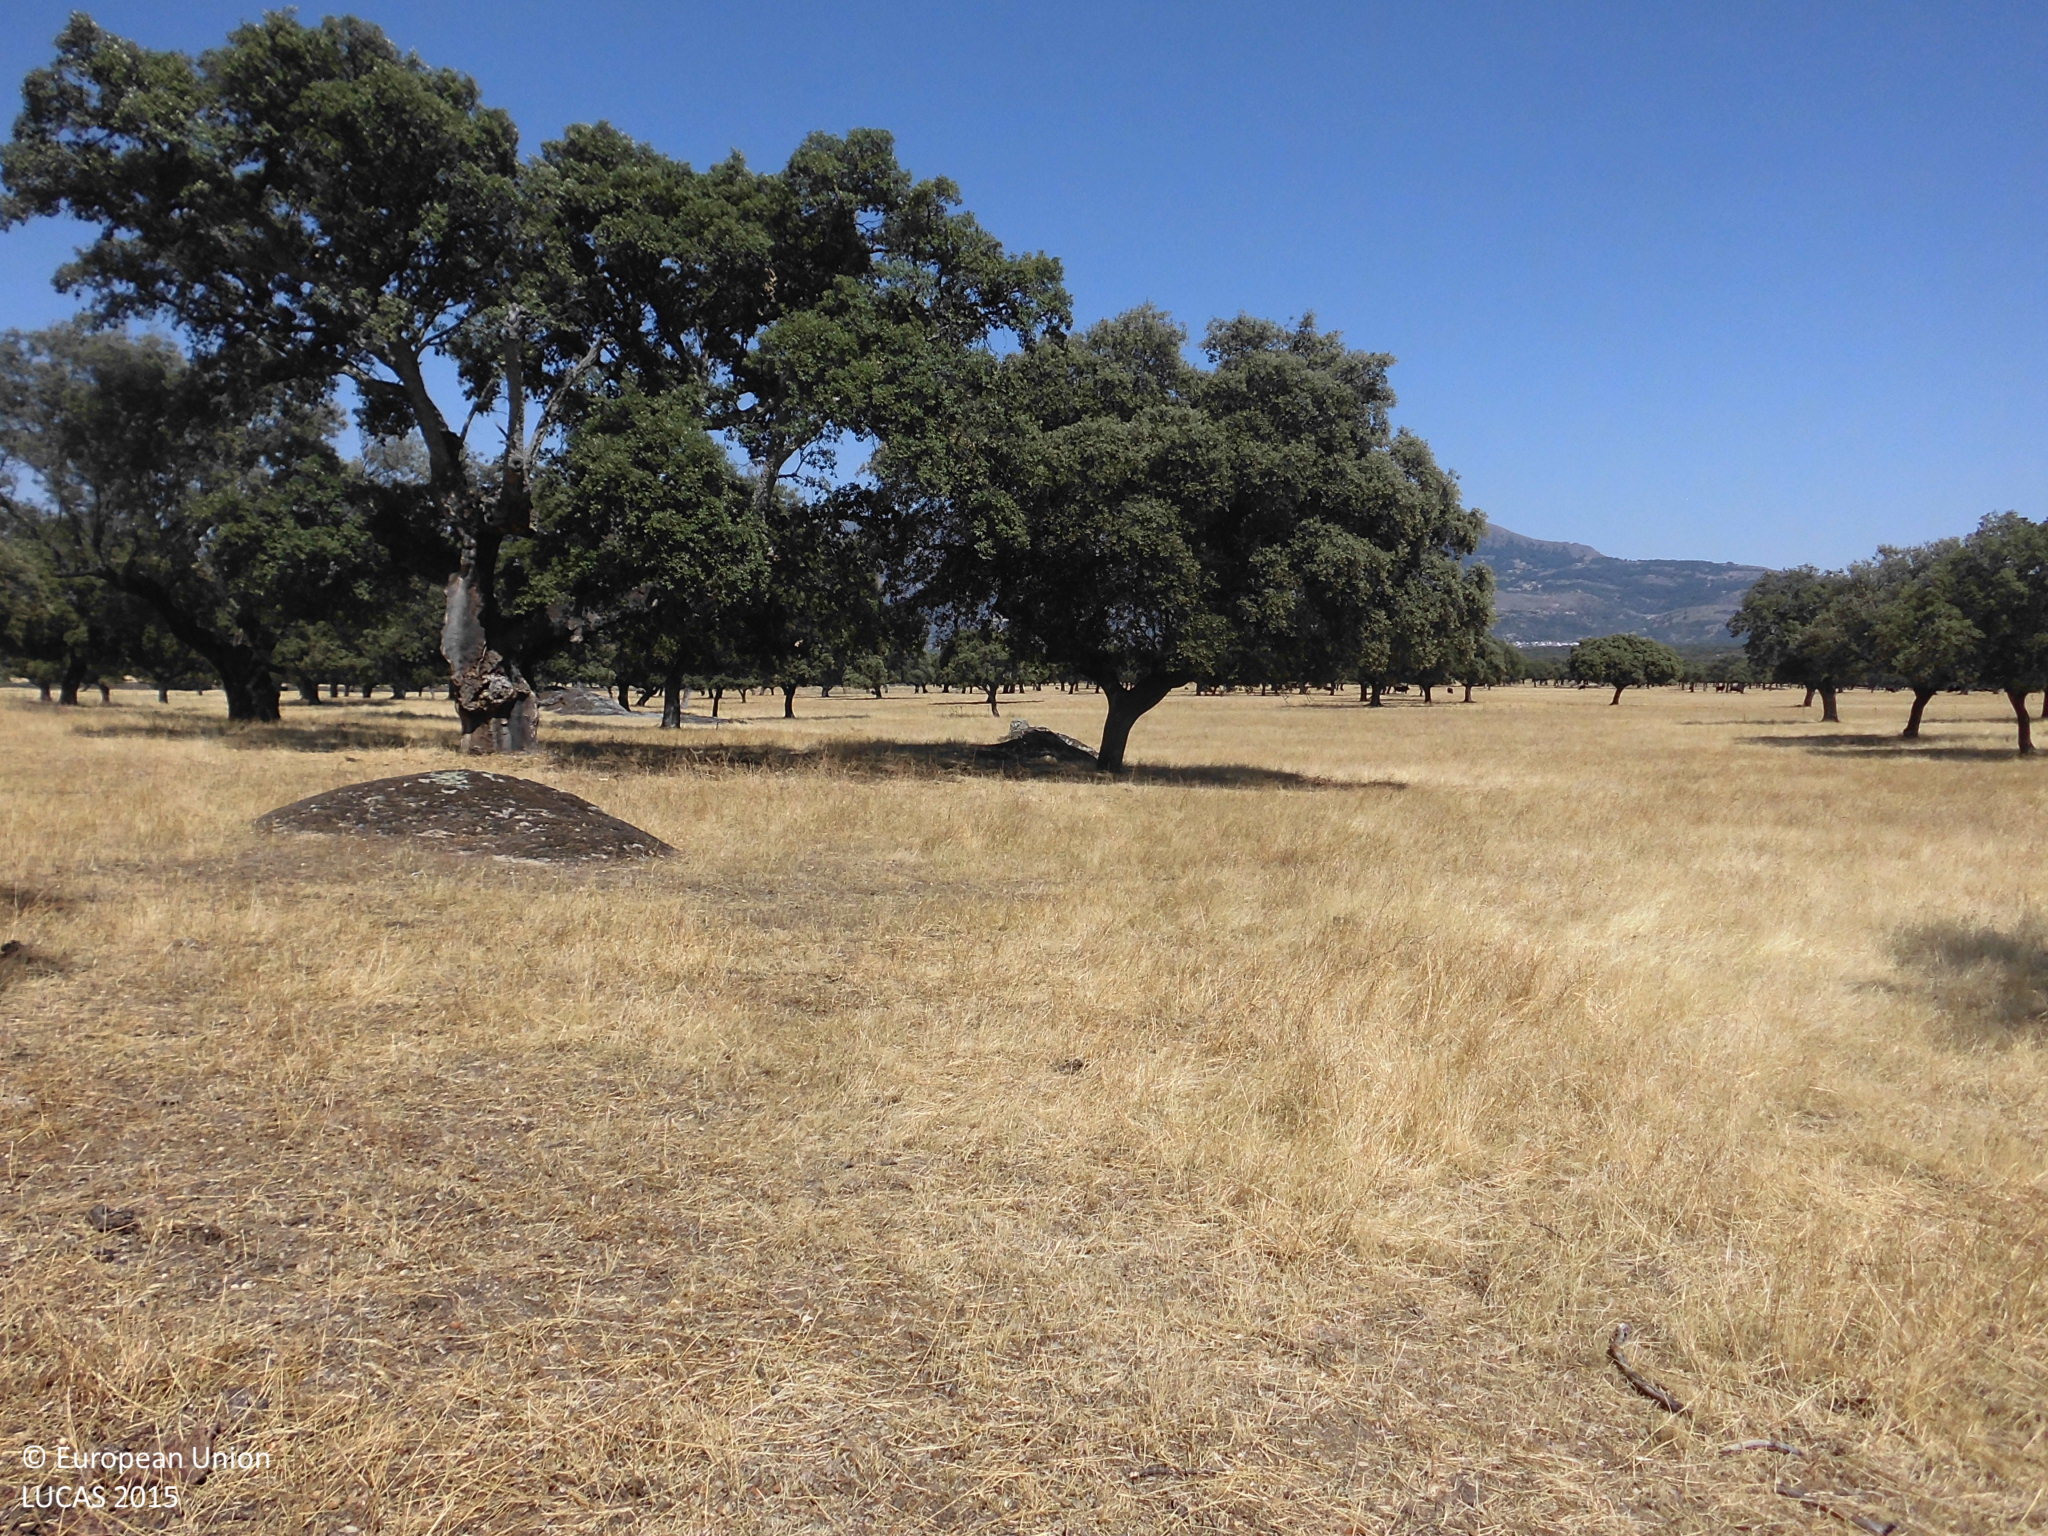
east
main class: Woodland
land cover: Broadleaved woodland
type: broadleaved evergreen forest
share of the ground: 25 - 50 %
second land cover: Grassland without tree/shrub cover
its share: > 75 %
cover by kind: herbaceous plants 70 %, broadleaved forest trees 30 %
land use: Forestry
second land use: Agriculture (excluding fallow land and kitchen gardens)
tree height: > 5 m
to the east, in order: Broadleaved woodland; Grassland without tree/shrub cover; Broadleaved woodland
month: July
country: ES
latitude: 40.1609
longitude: -6.1000
